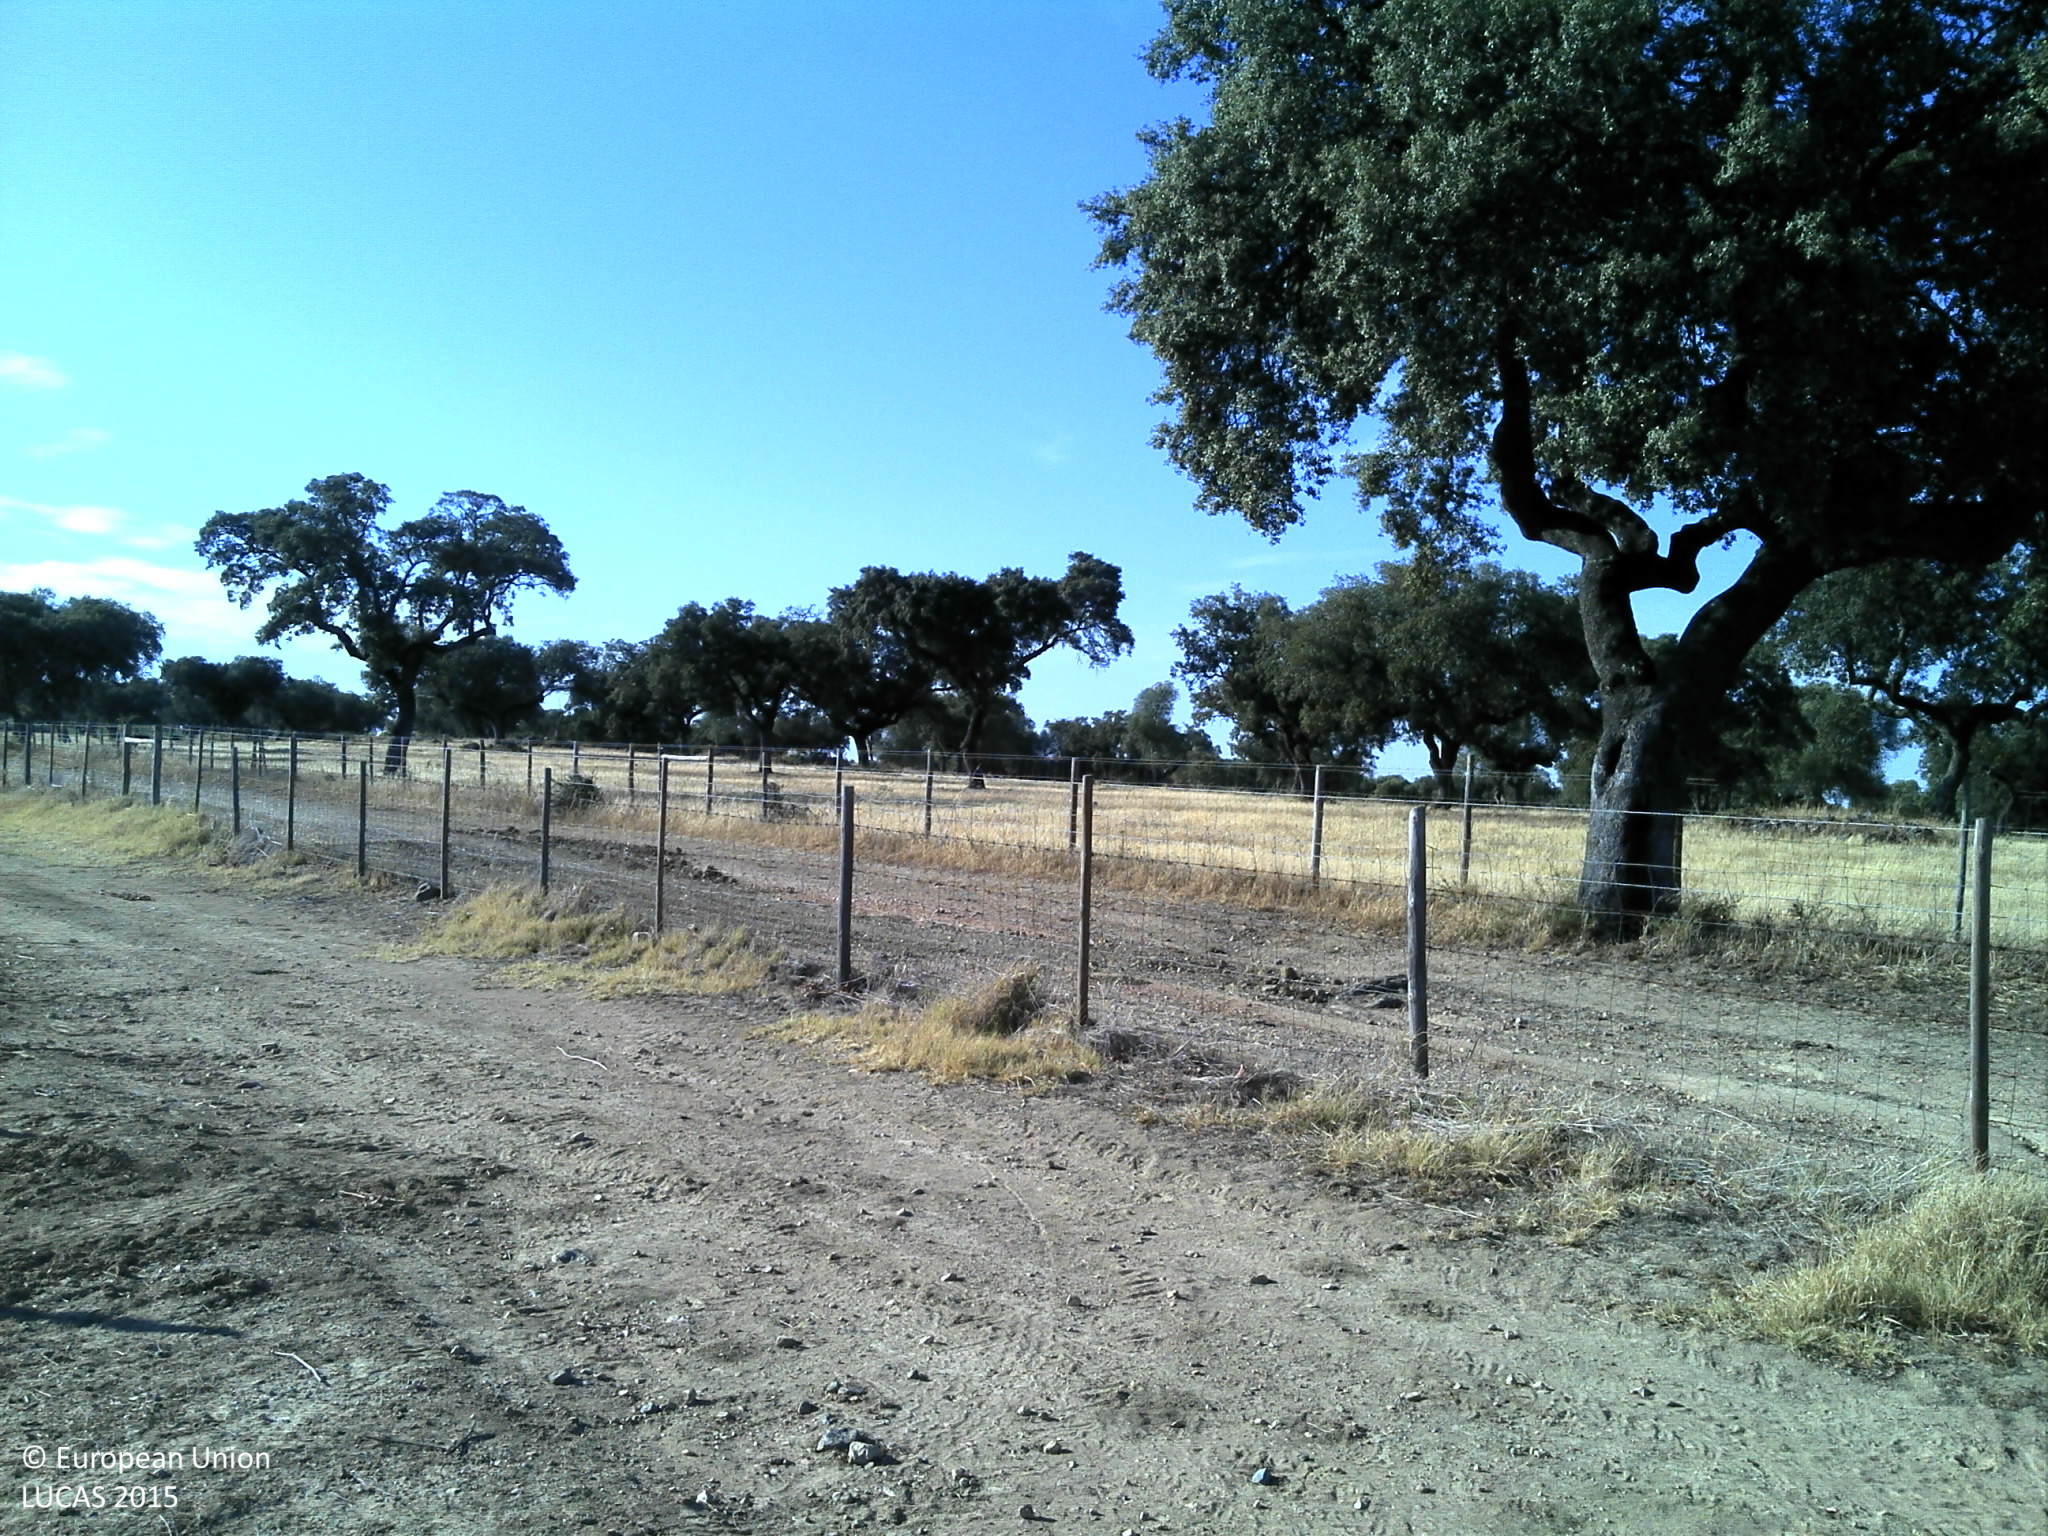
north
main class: Cropland
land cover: Vineyards
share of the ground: 50 - 75 %
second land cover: Other bare soil
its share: > 75 %
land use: Agriculture (excluding fallow land and kitchen gardens)
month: June
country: PT
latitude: 38.2744
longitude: -8.0873
